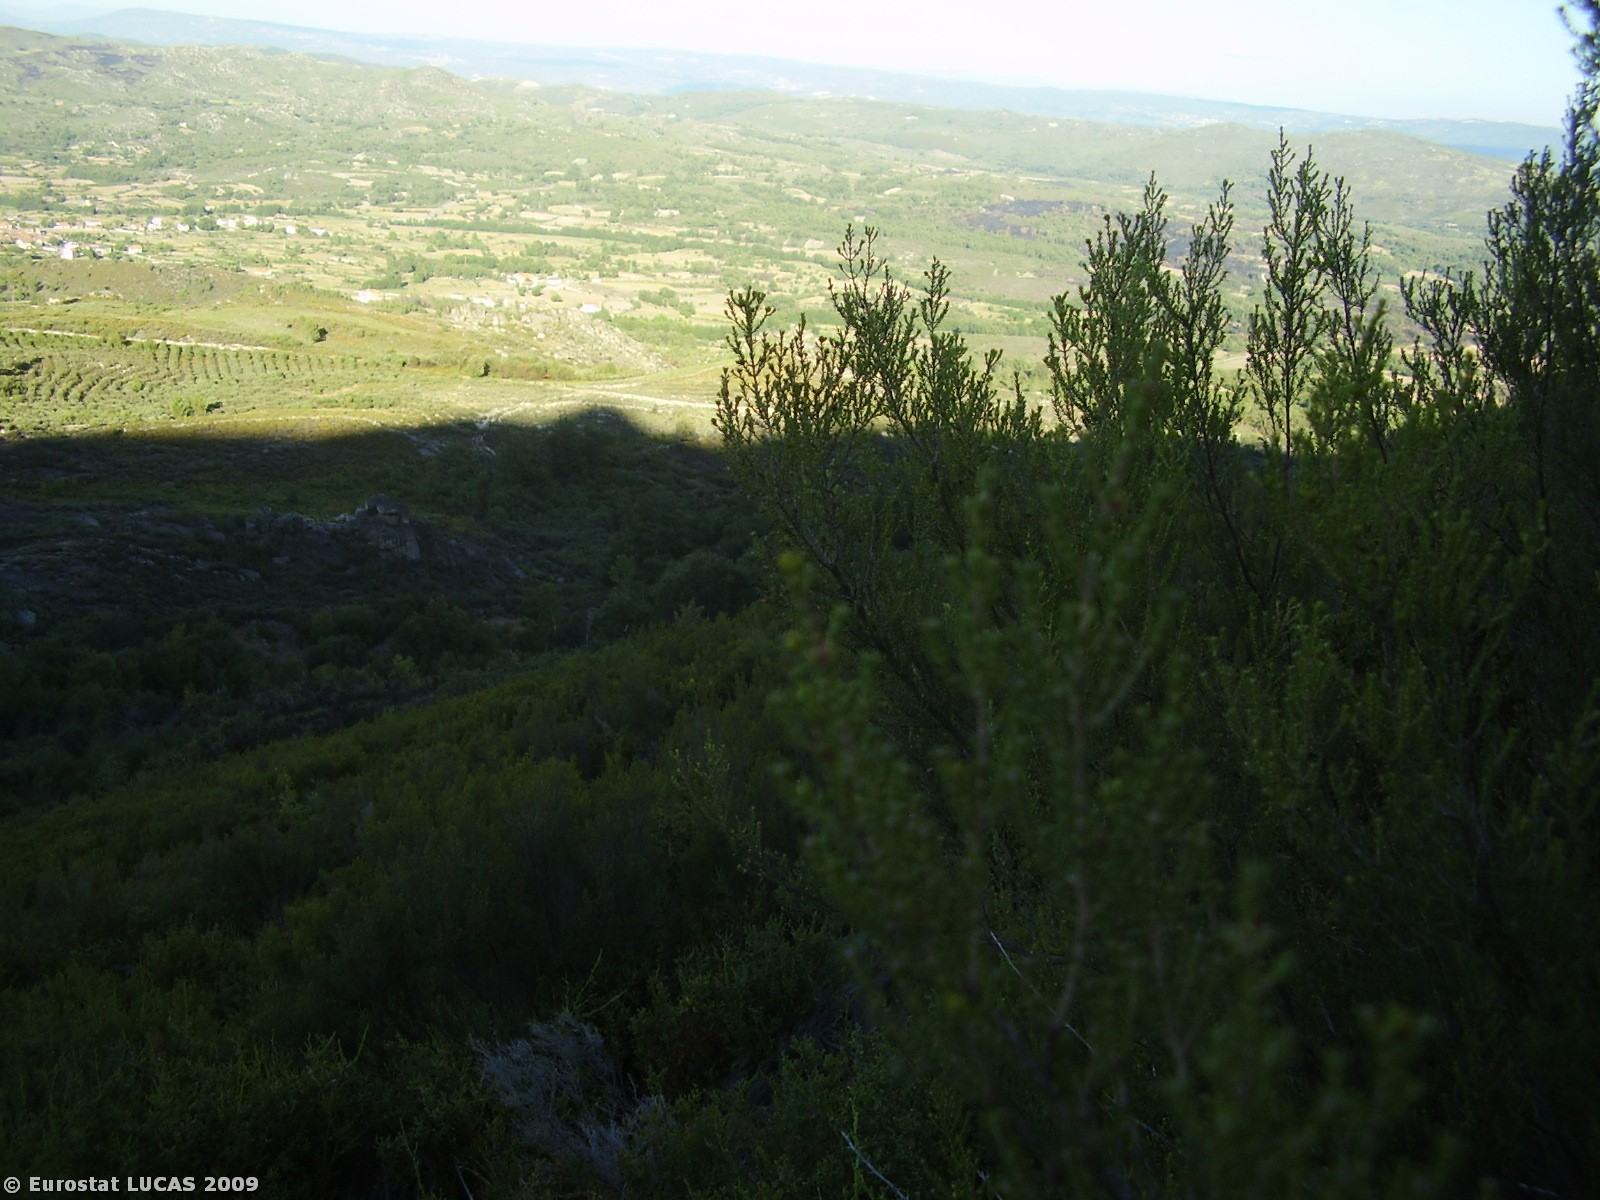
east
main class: Shrubland
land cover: Shrubland without tree cover
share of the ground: > 75 %
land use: Fallow land
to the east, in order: Shrubland without tree cover; Shrubland with sparse tree cover; Tracks; Shrubland with sparse tree cover; Broadleaved woodland
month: September
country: PT
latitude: 41.7563
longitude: -7.6341
